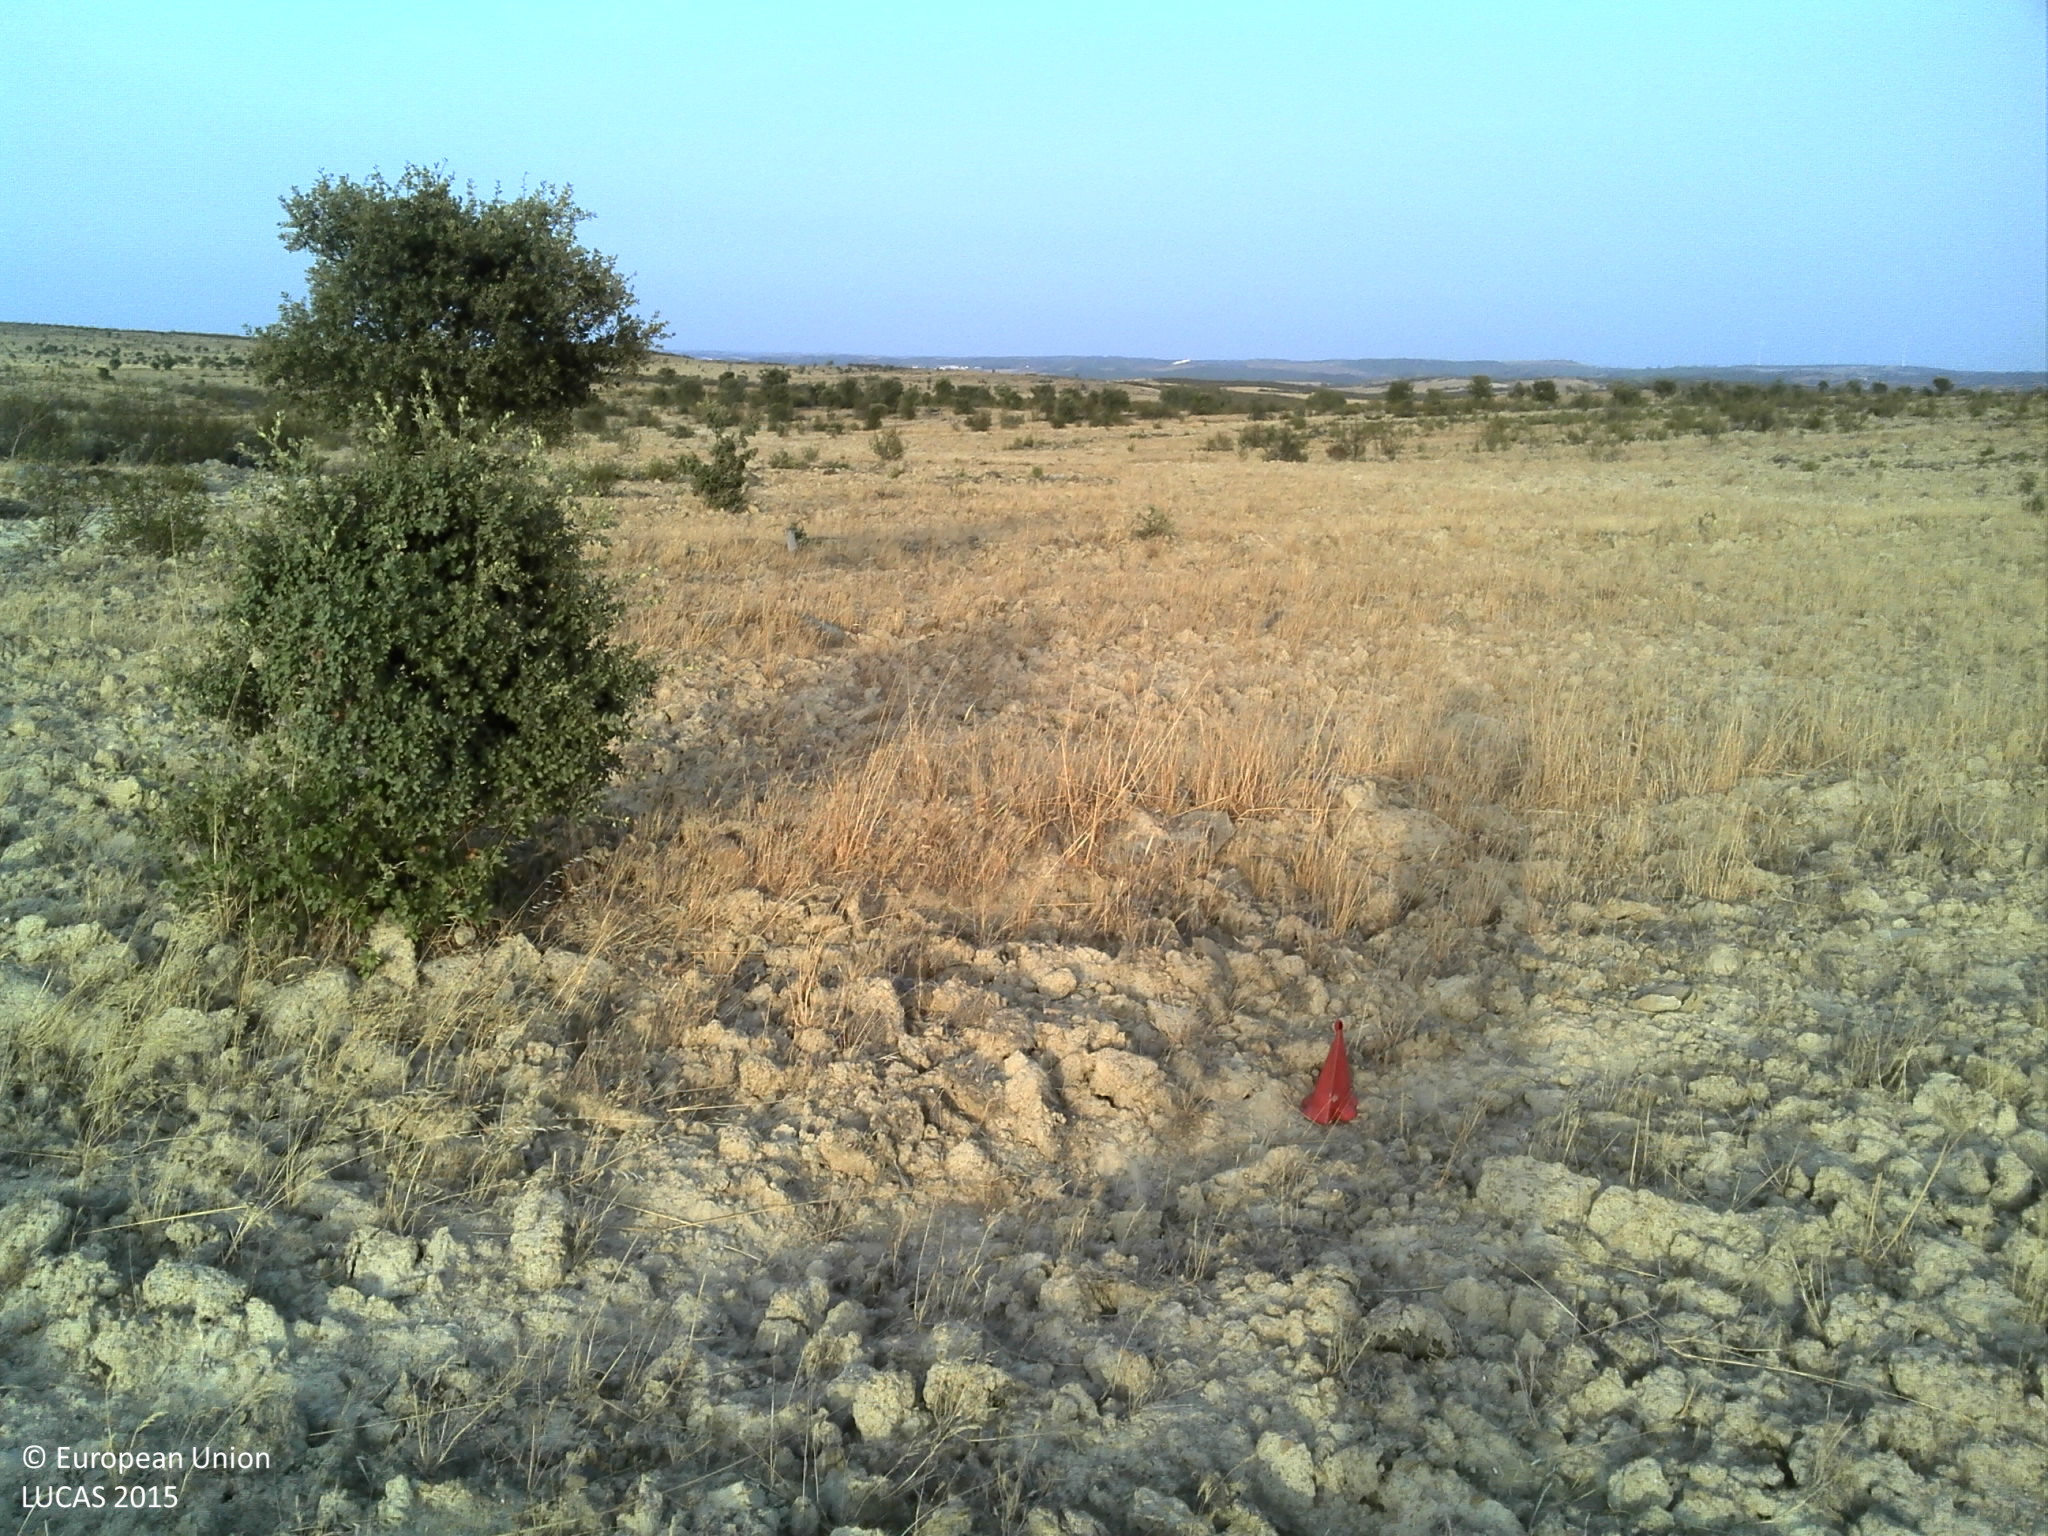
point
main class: Grassland
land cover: Grassland with sparse tree/shrub cover
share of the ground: 50 - 75 %
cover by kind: unconsolidated bare surface 80 %, herbaceous plants 15 %, broadleaved forest trees 5 %
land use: Forestry
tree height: < 5 m
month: July
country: PT
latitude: 37.5491
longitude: -7.9147
